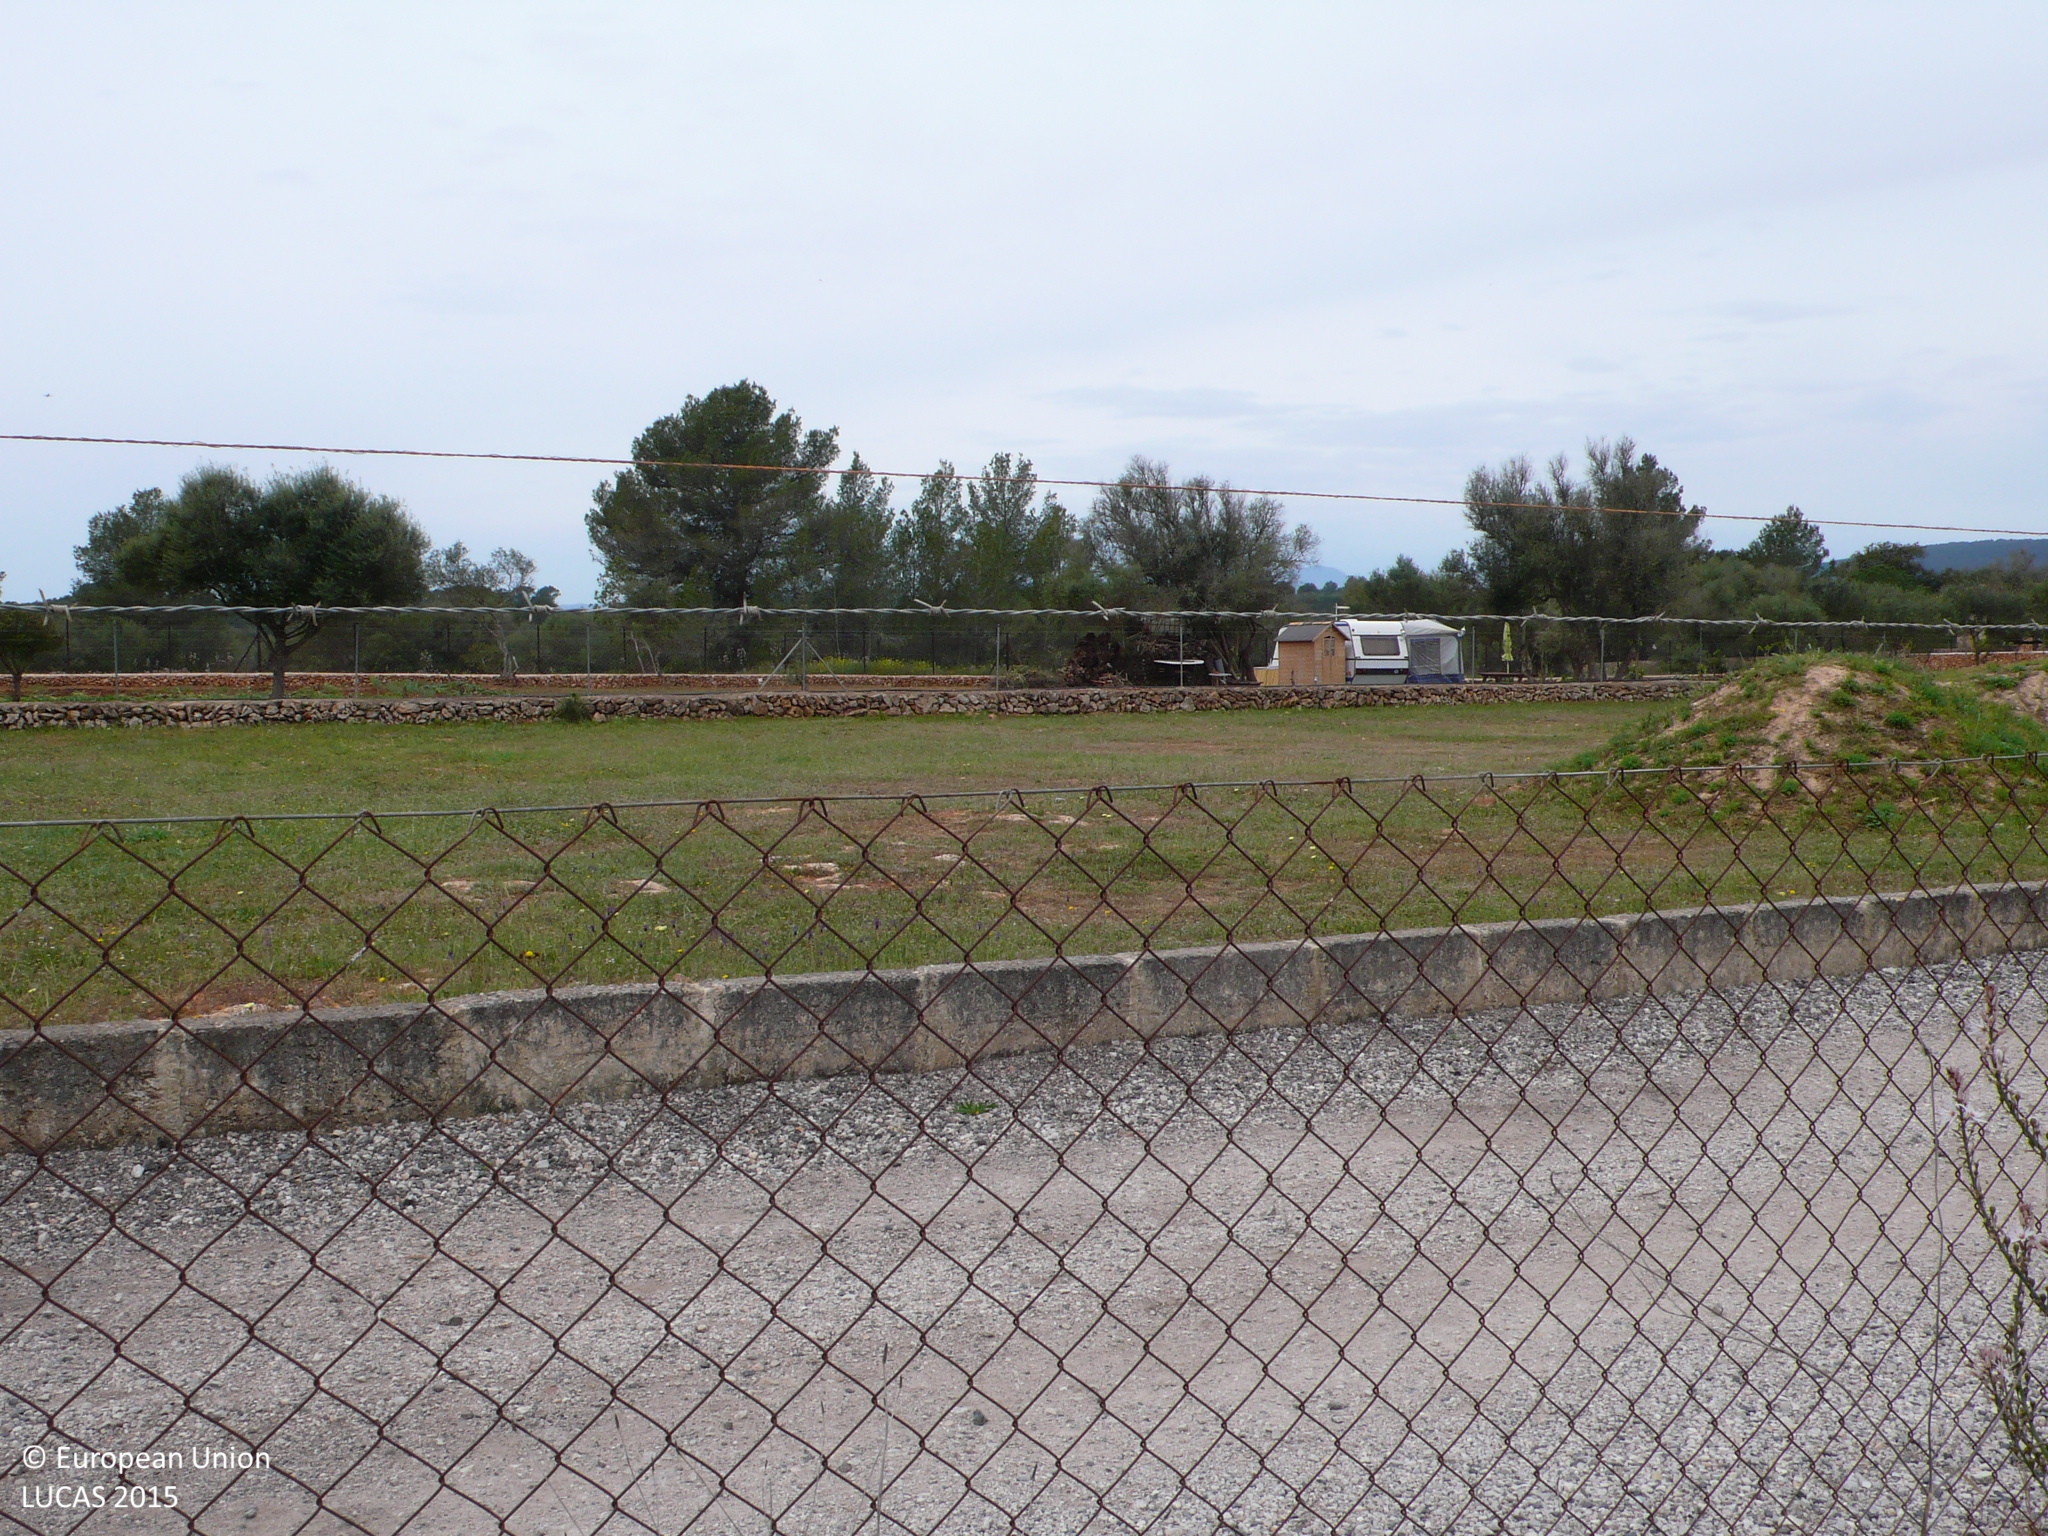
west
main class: Grassland
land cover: Grassland with sparse tree/shrub cover
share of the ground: > 75 %
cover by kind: herbaceous plants 75 %, consolidated bare surface 20 %, broadleaved forest trees 5 %
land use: Residential
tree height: < 5 m
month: April
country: ES
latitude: 39.5898
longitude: 2.8692
